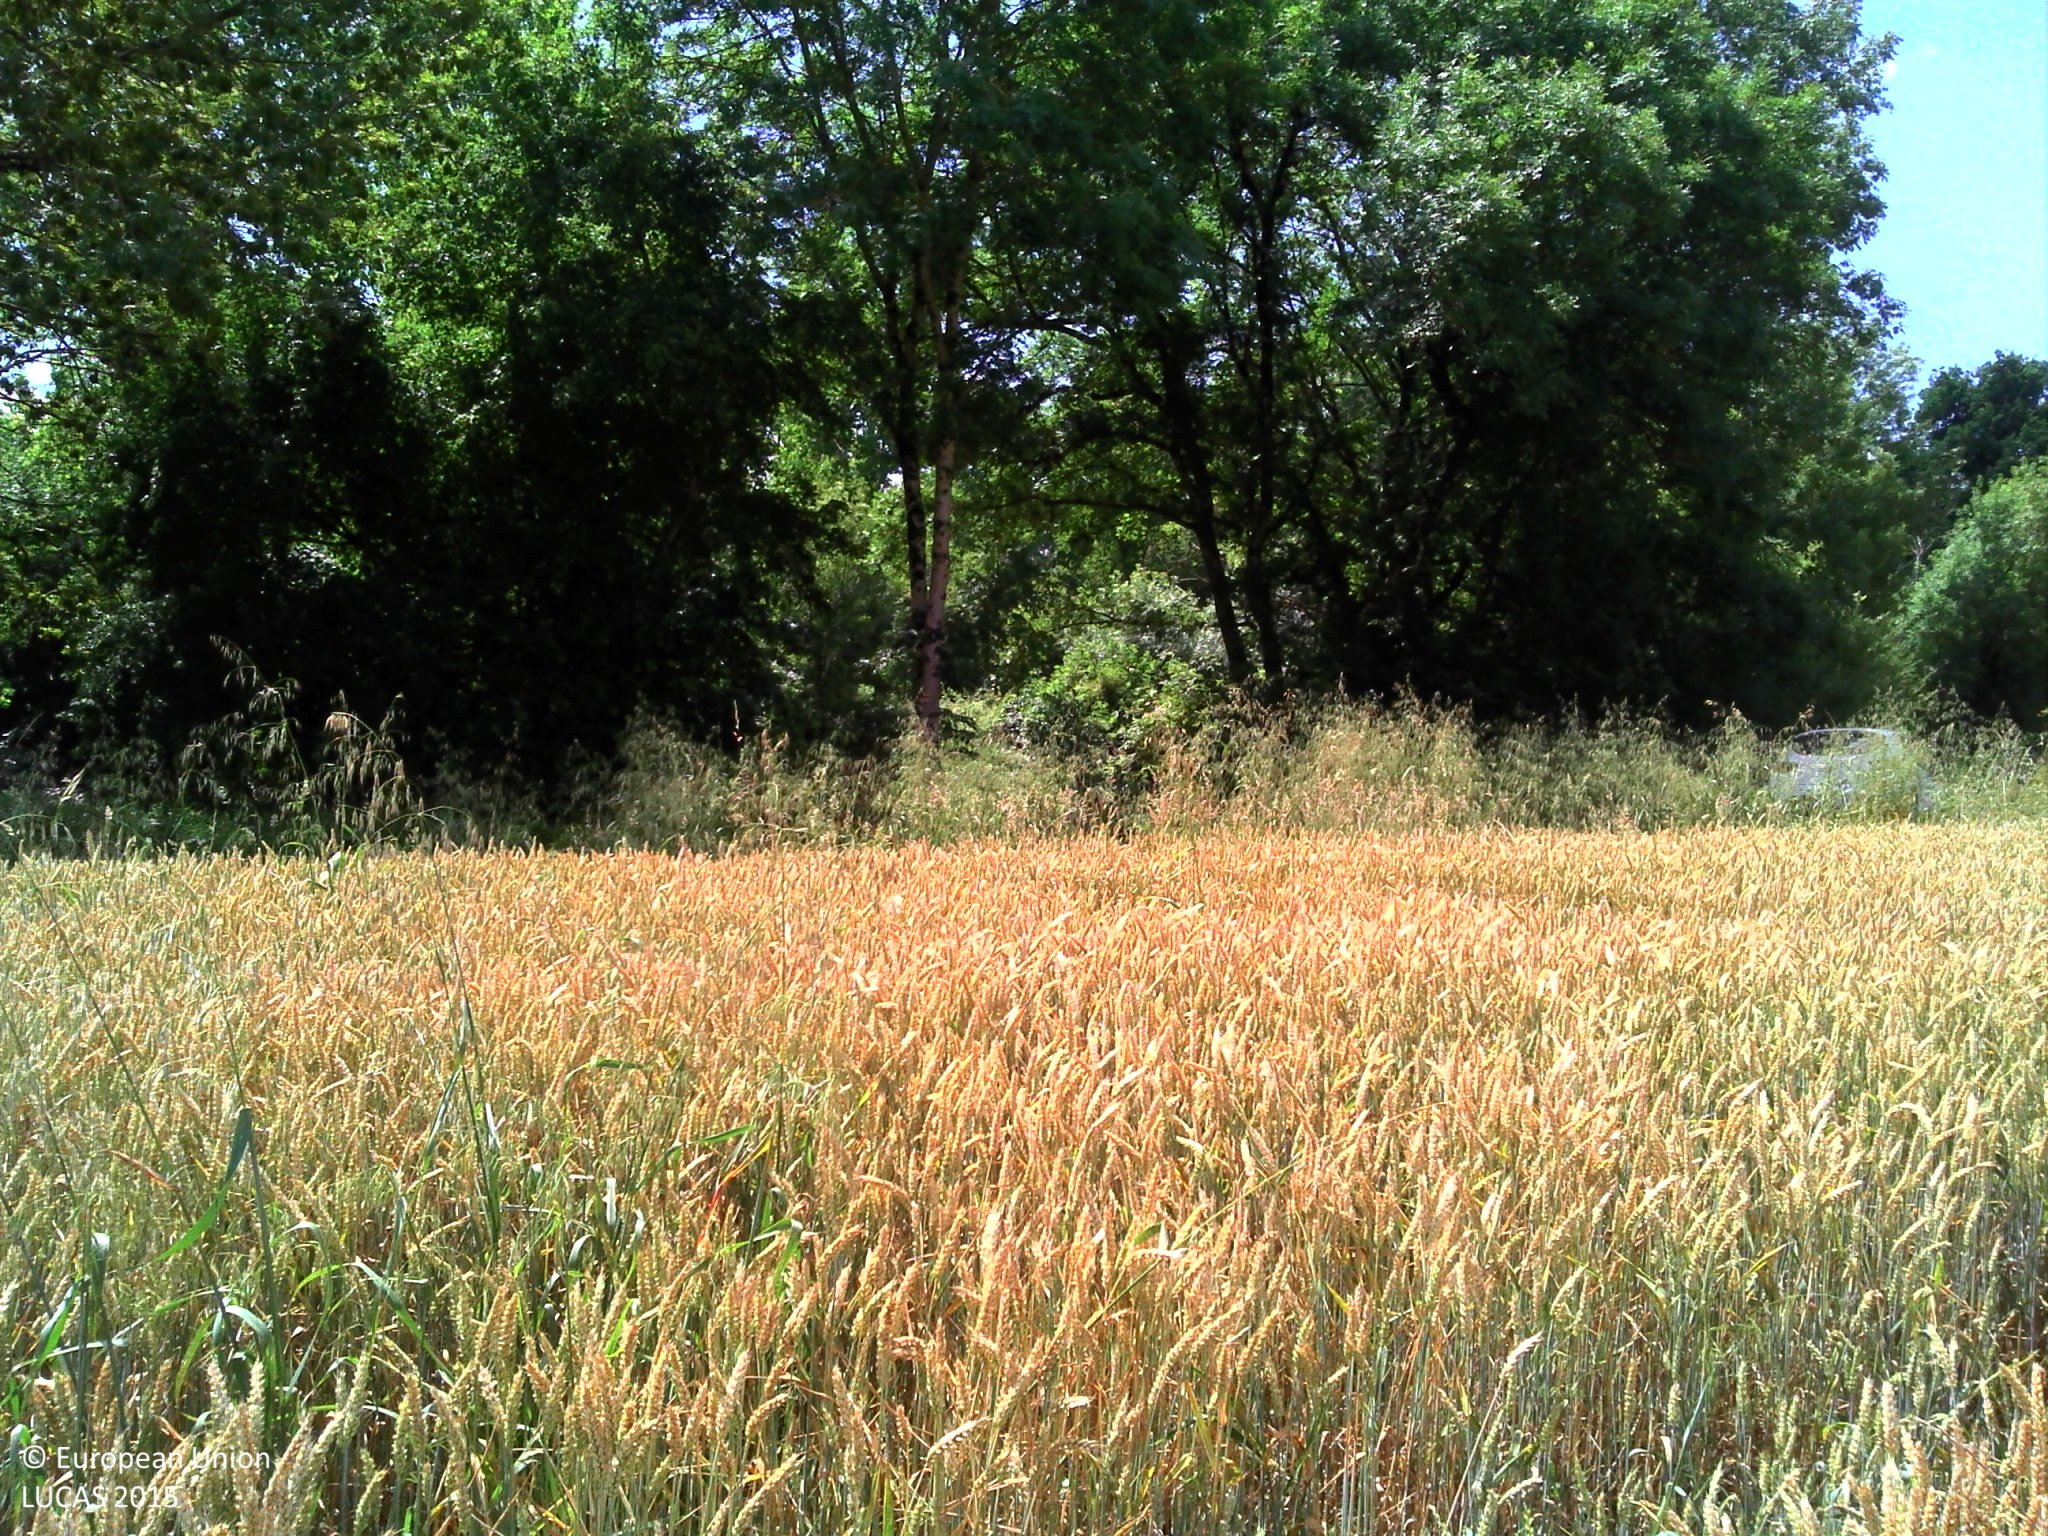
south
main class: Cropland
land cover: Common wheat
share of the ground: > 75 %
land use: Agriculture (excluding fallow land and kitchen gardens)
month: June
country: FR
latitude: 45.7692
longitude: 0.3532
